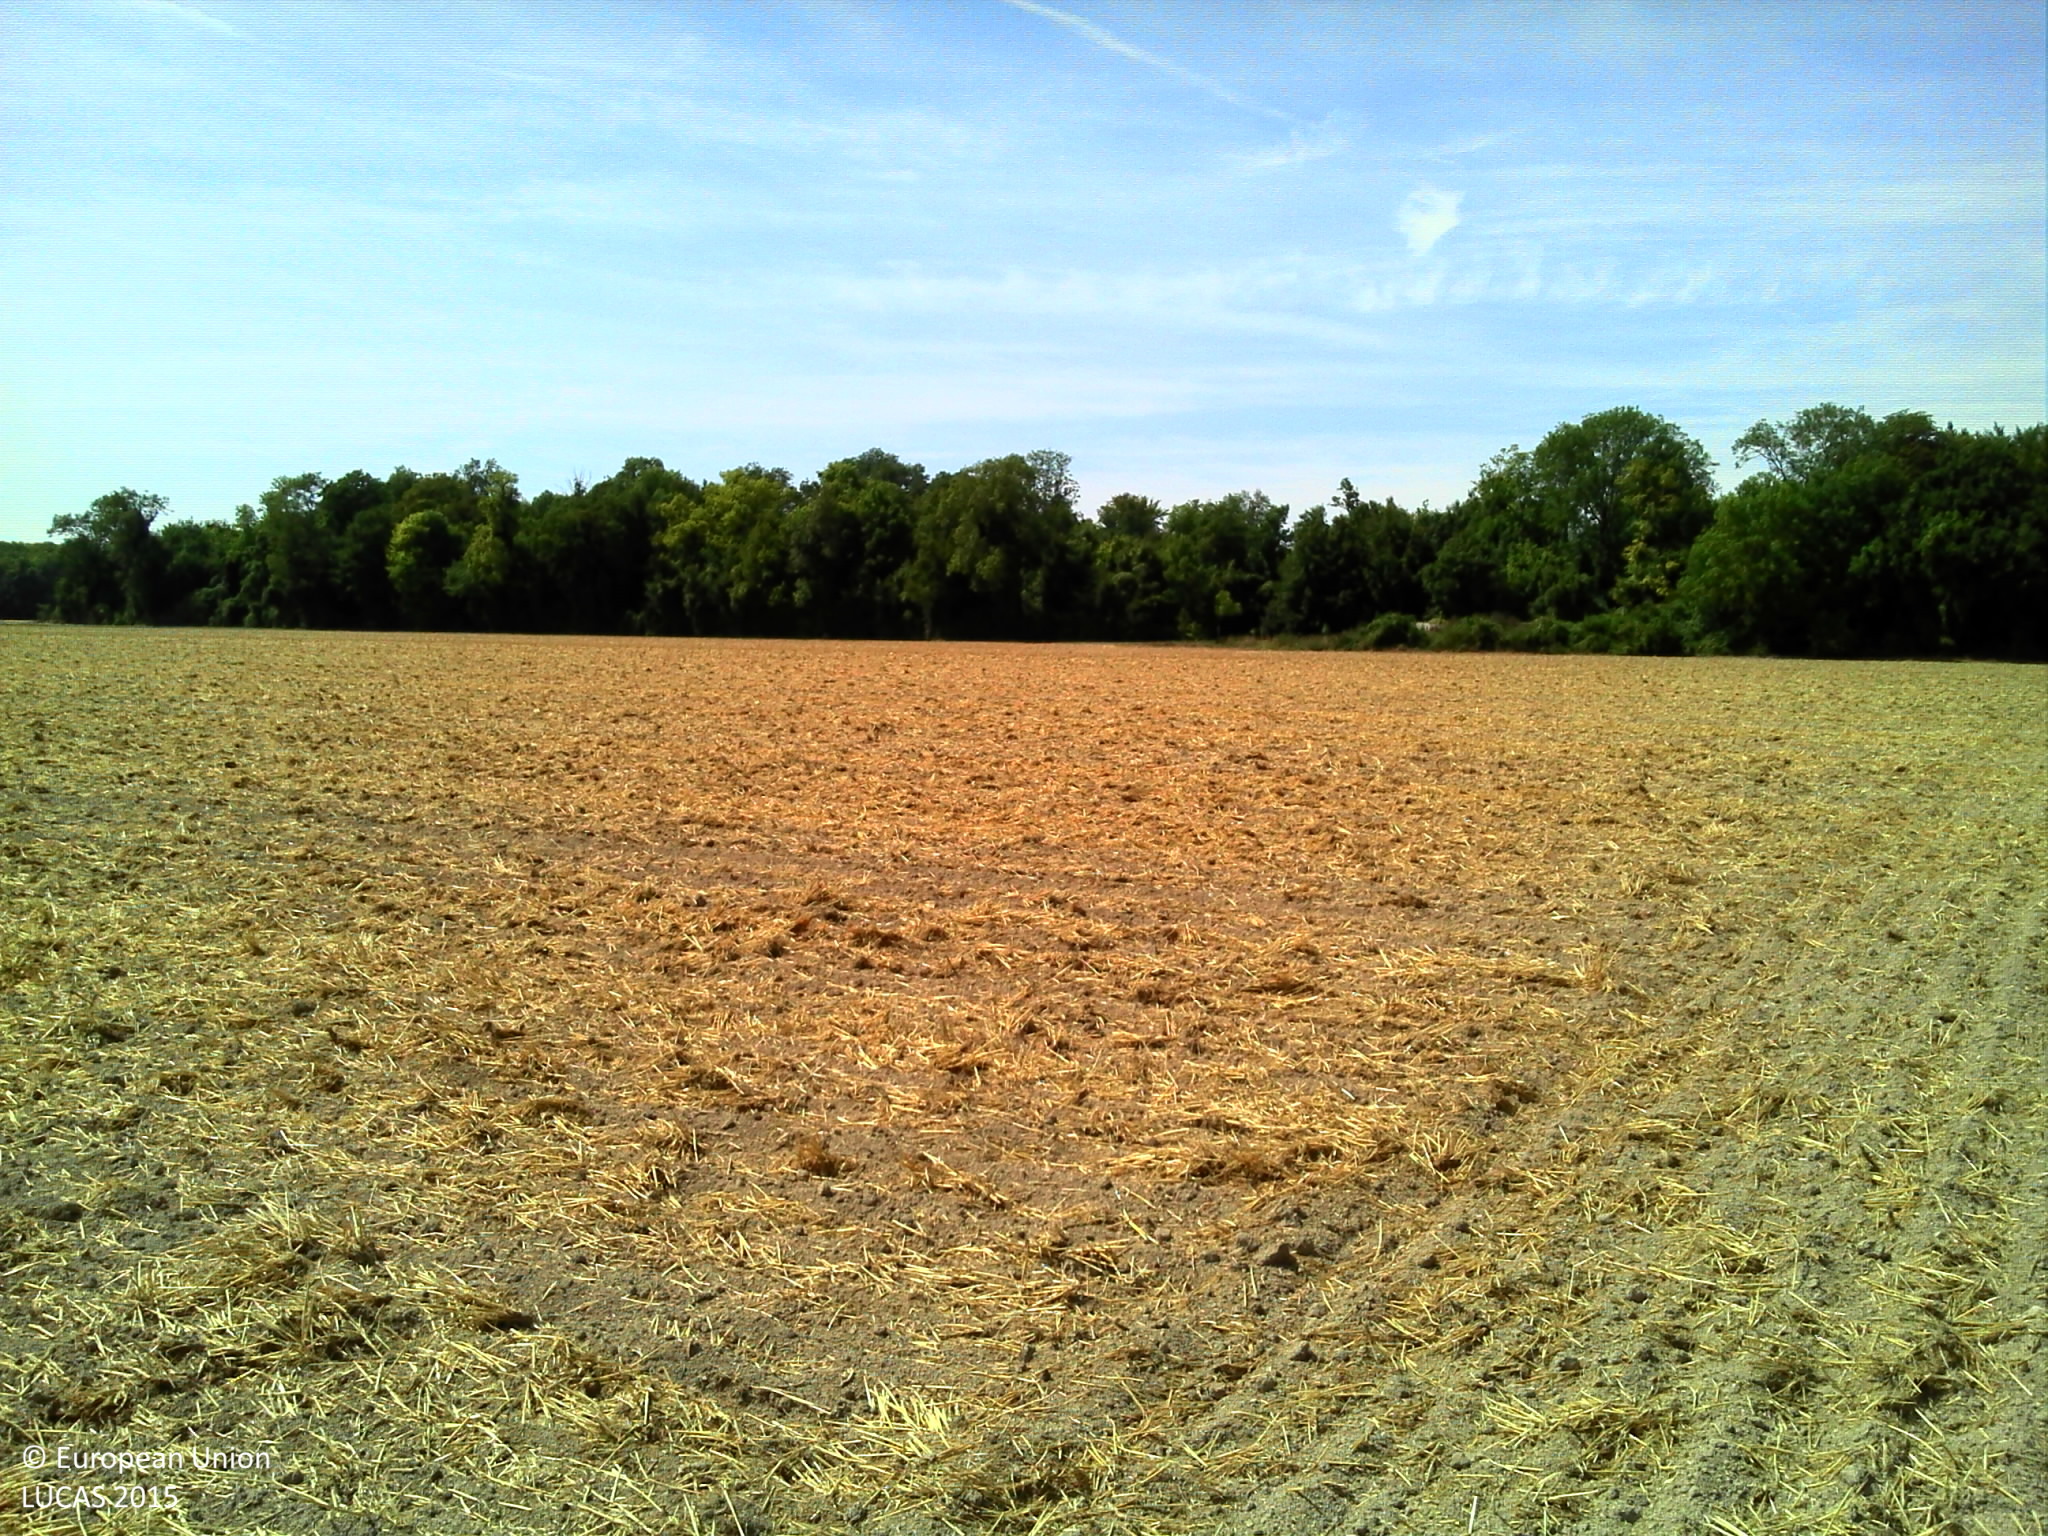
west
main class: Cropland
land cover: Common wheat
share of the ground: > 75 %
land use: Agriculture (excluding fallow land and kitchen gardens)
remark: Harvested field
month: August
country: FR
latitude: 48.9722
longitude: 4.1898
